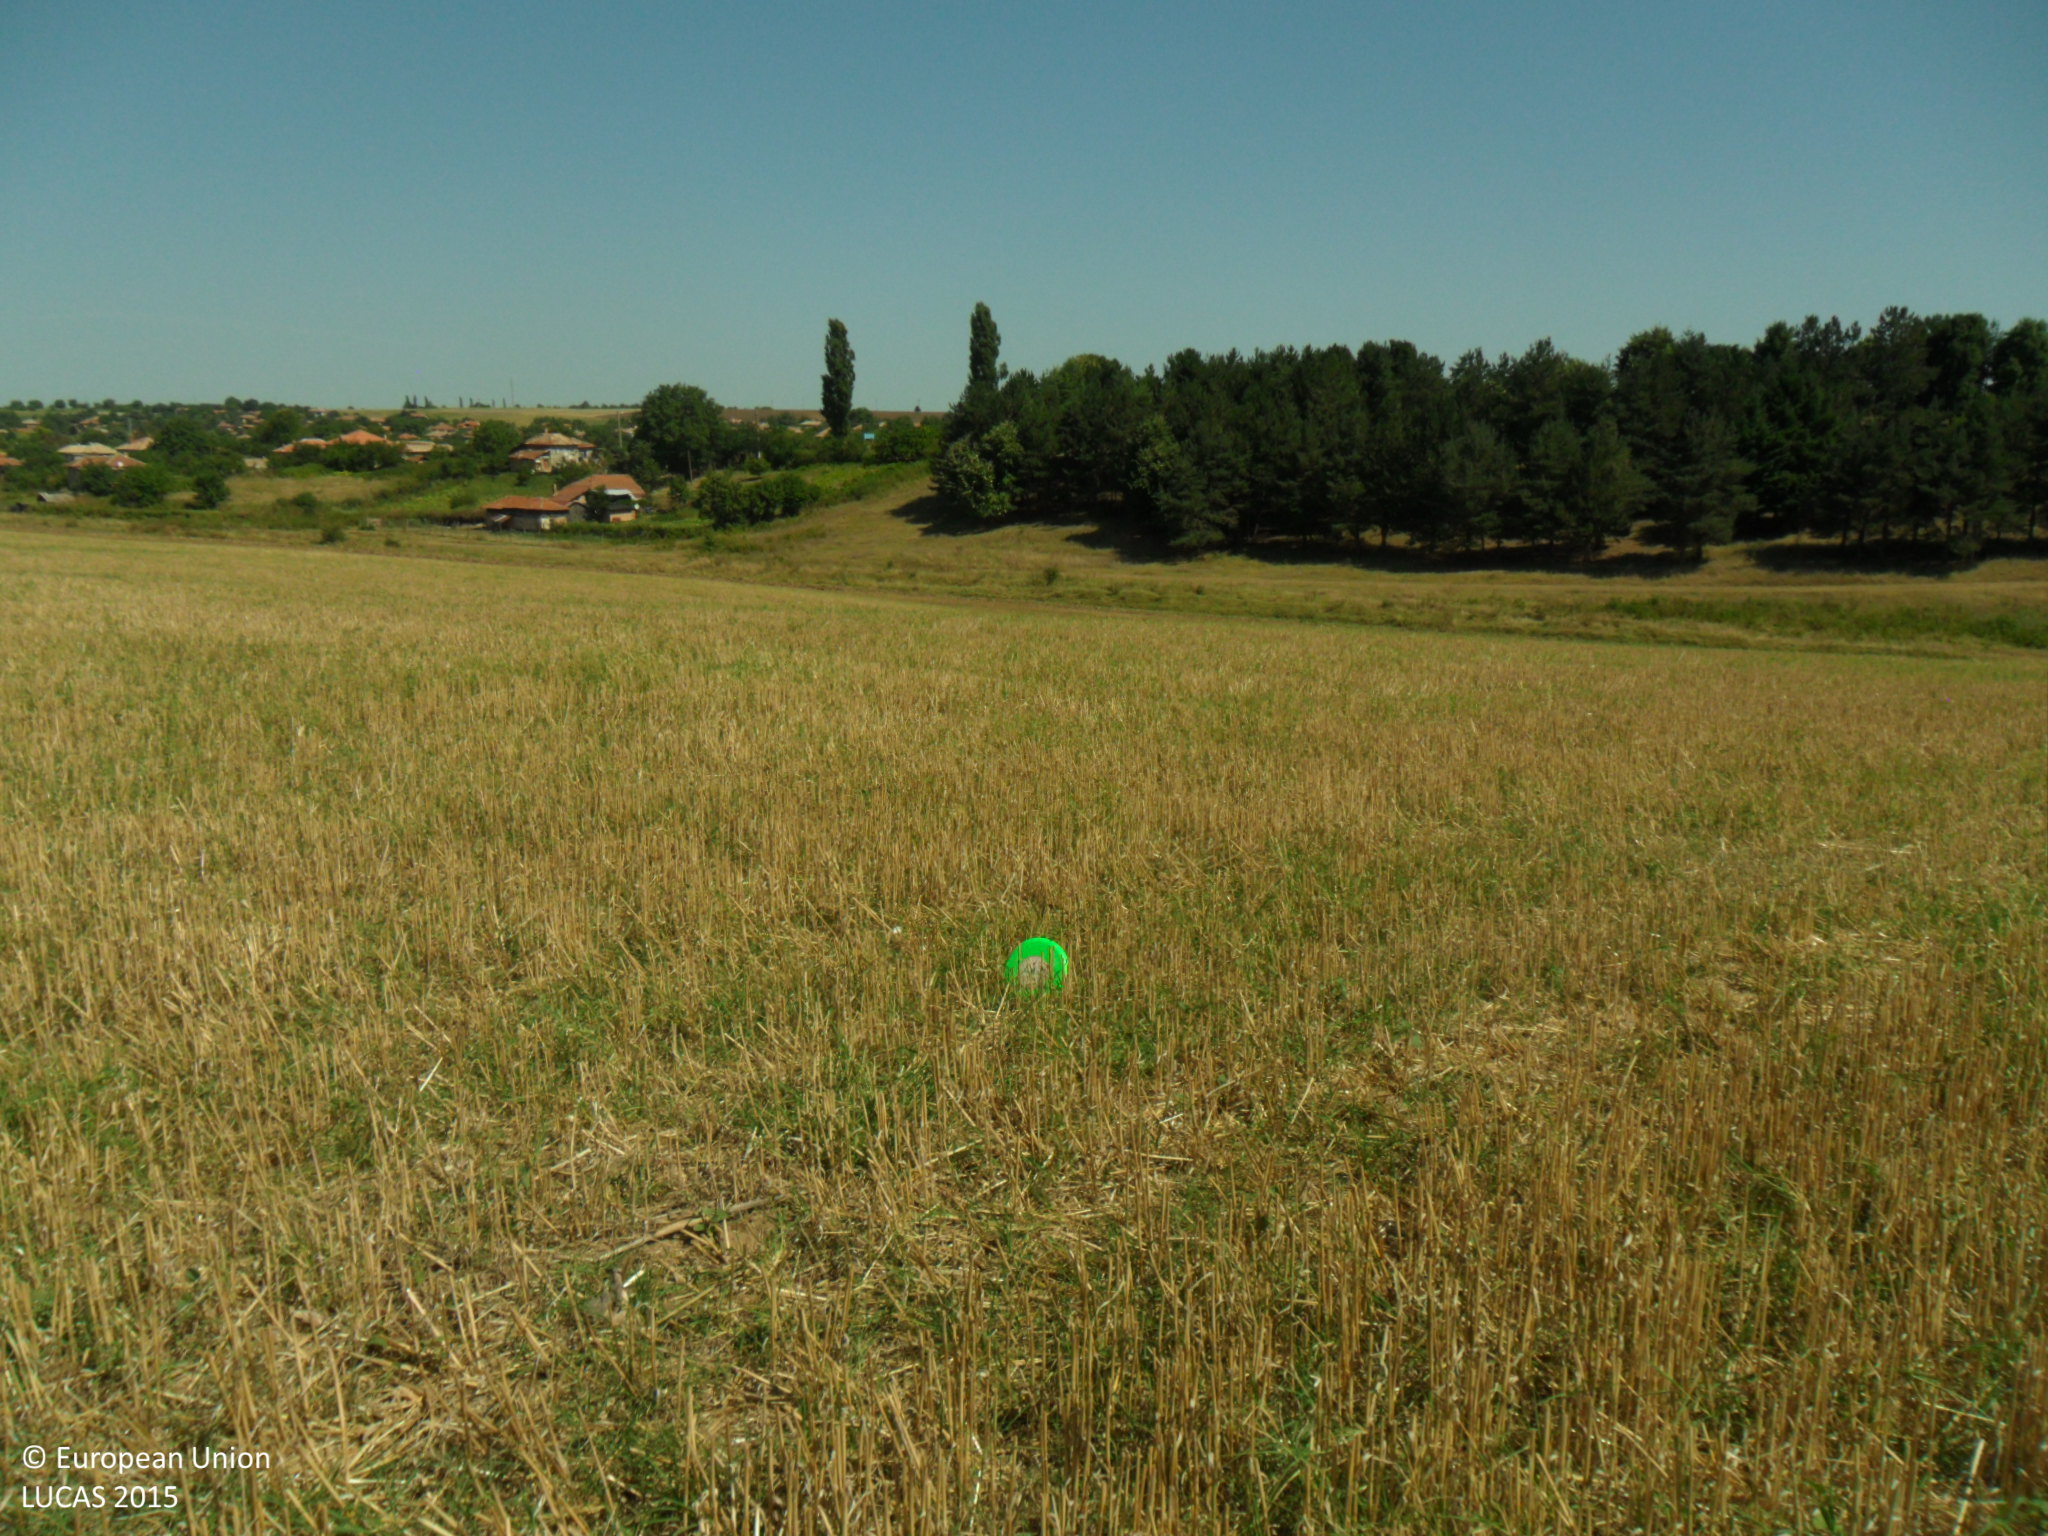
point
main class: Cropland
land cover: Common wheat
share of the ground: 50 - 75 %
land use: Agriculture (excluding fallow land and kitchen gardens)
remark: Harvested field
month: August
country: BG
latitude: 43.5937
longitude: 26.4677
